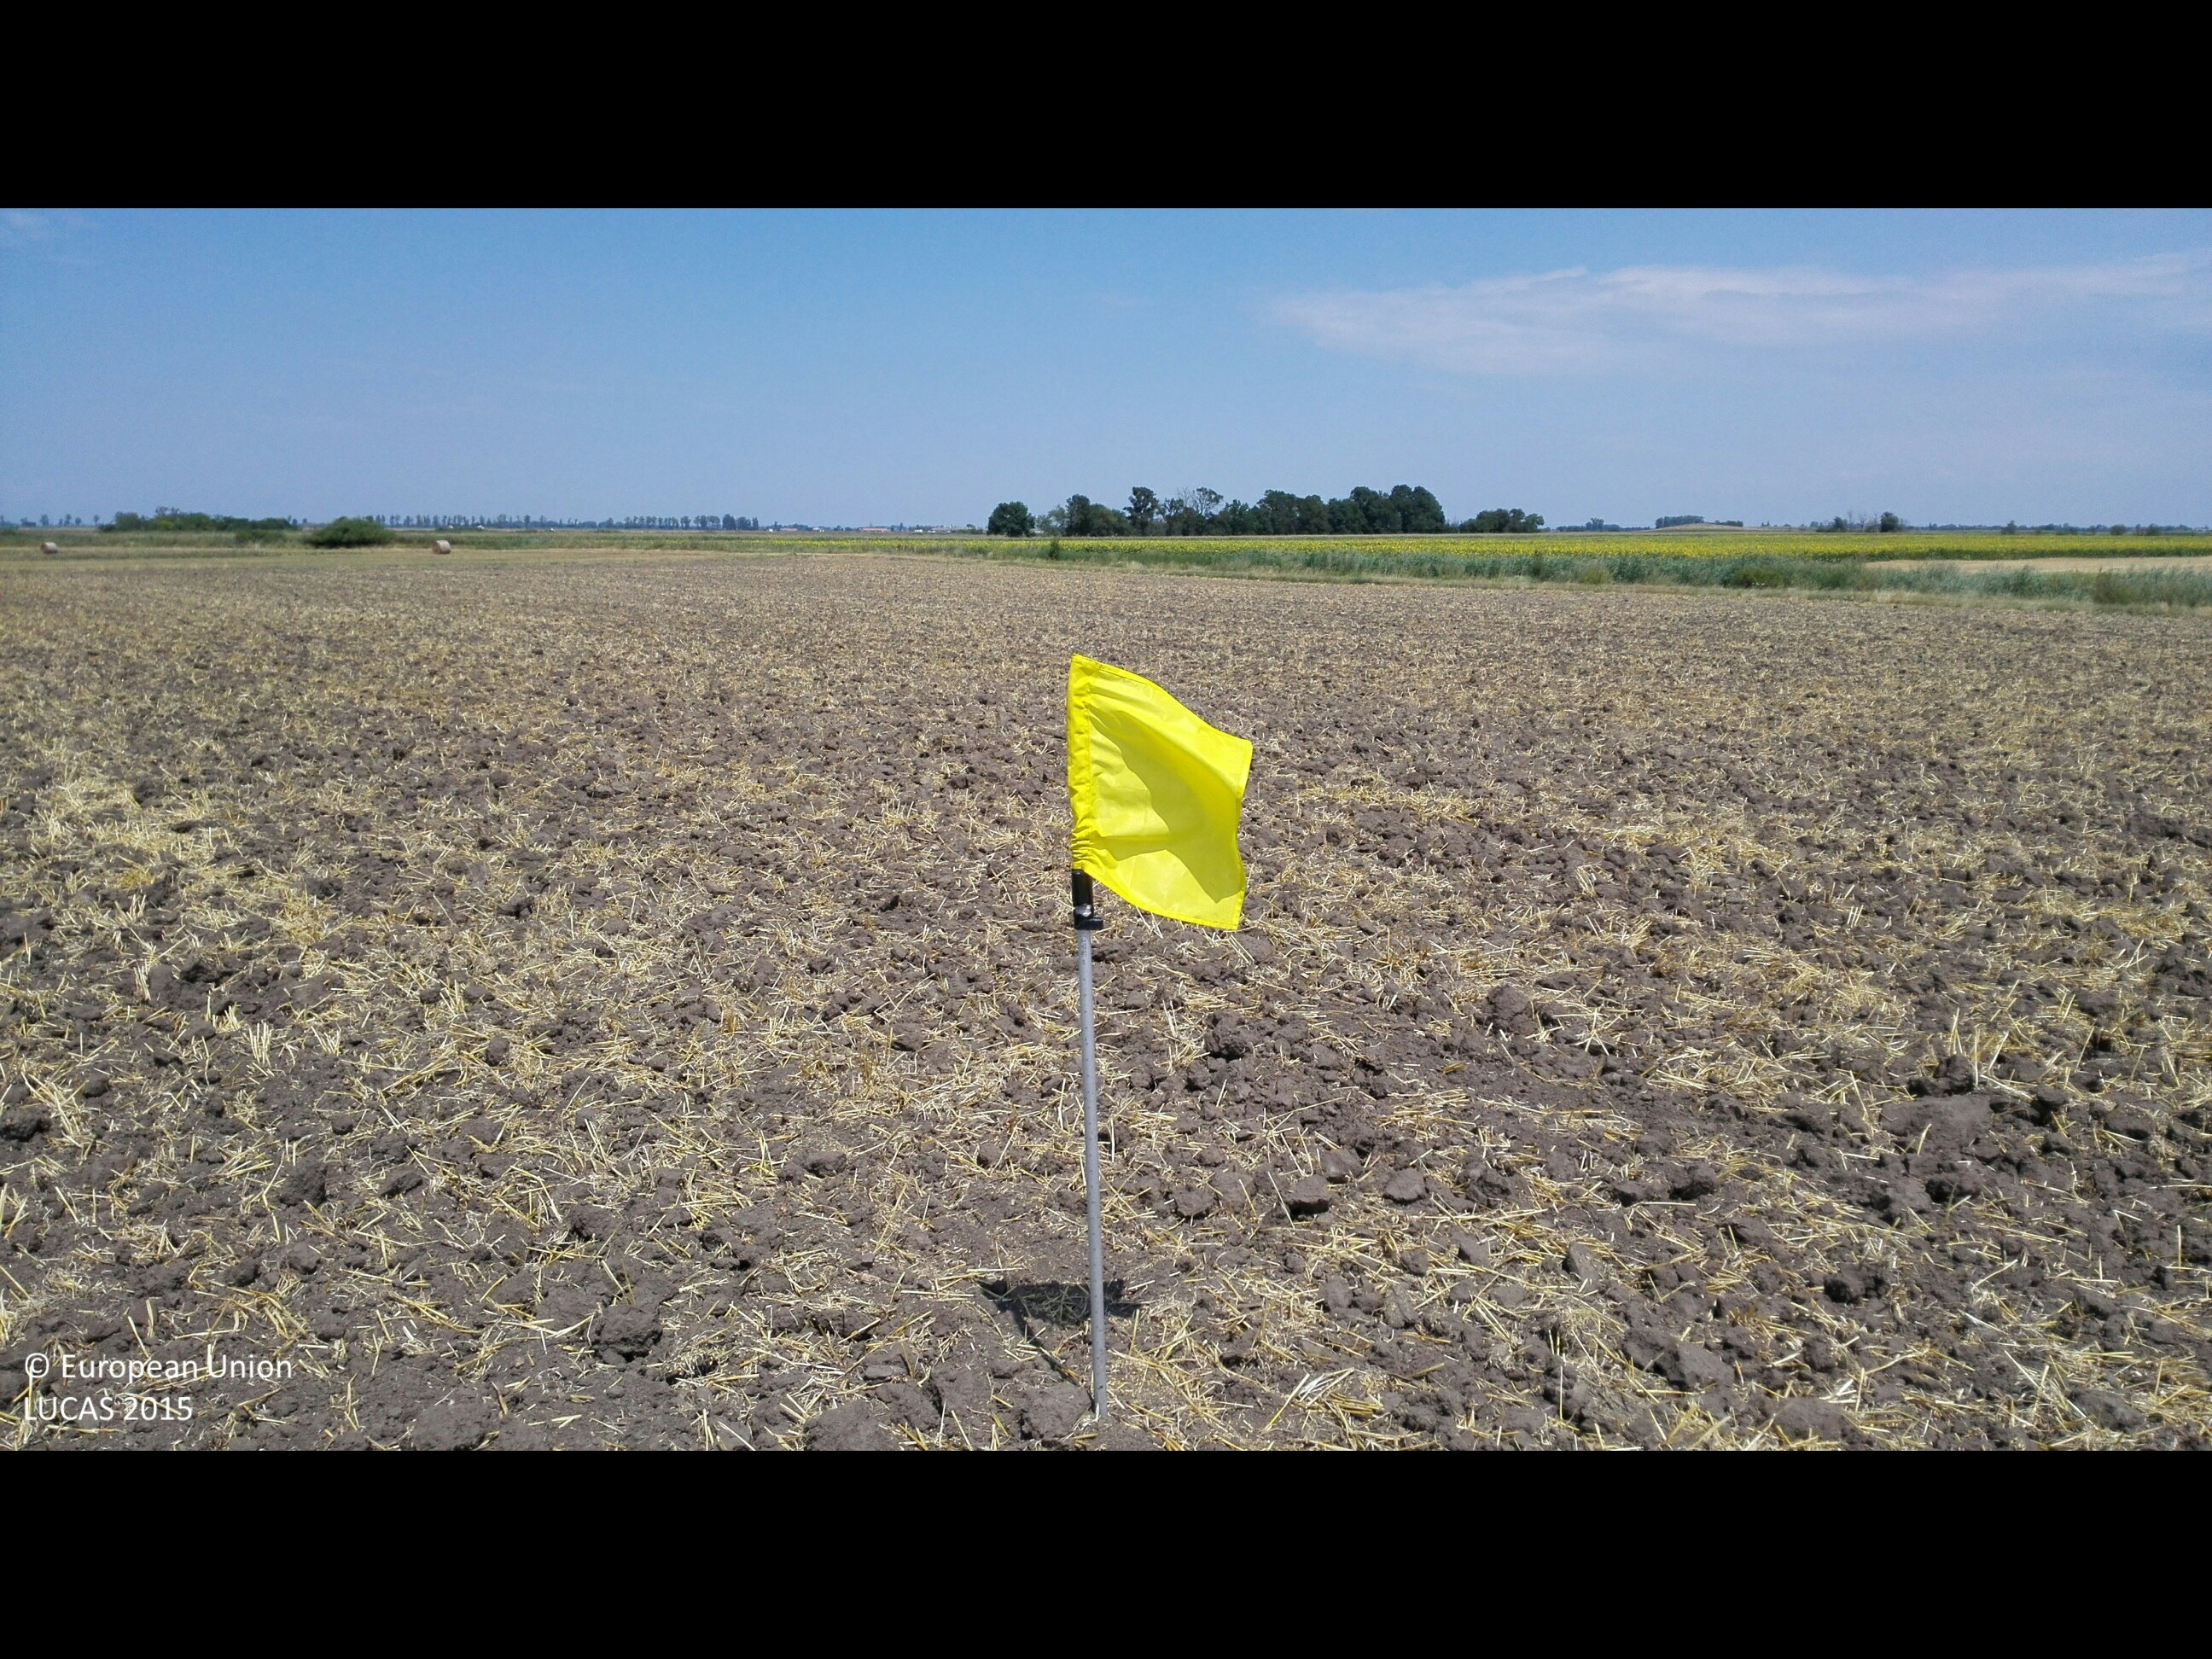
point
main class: Cropland
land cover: Barley
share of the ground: < 10 %
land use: Agriculture (excluding fallow land and kitchen gardens)
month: July
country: HU
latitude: 47.2400
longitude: 21.3075
